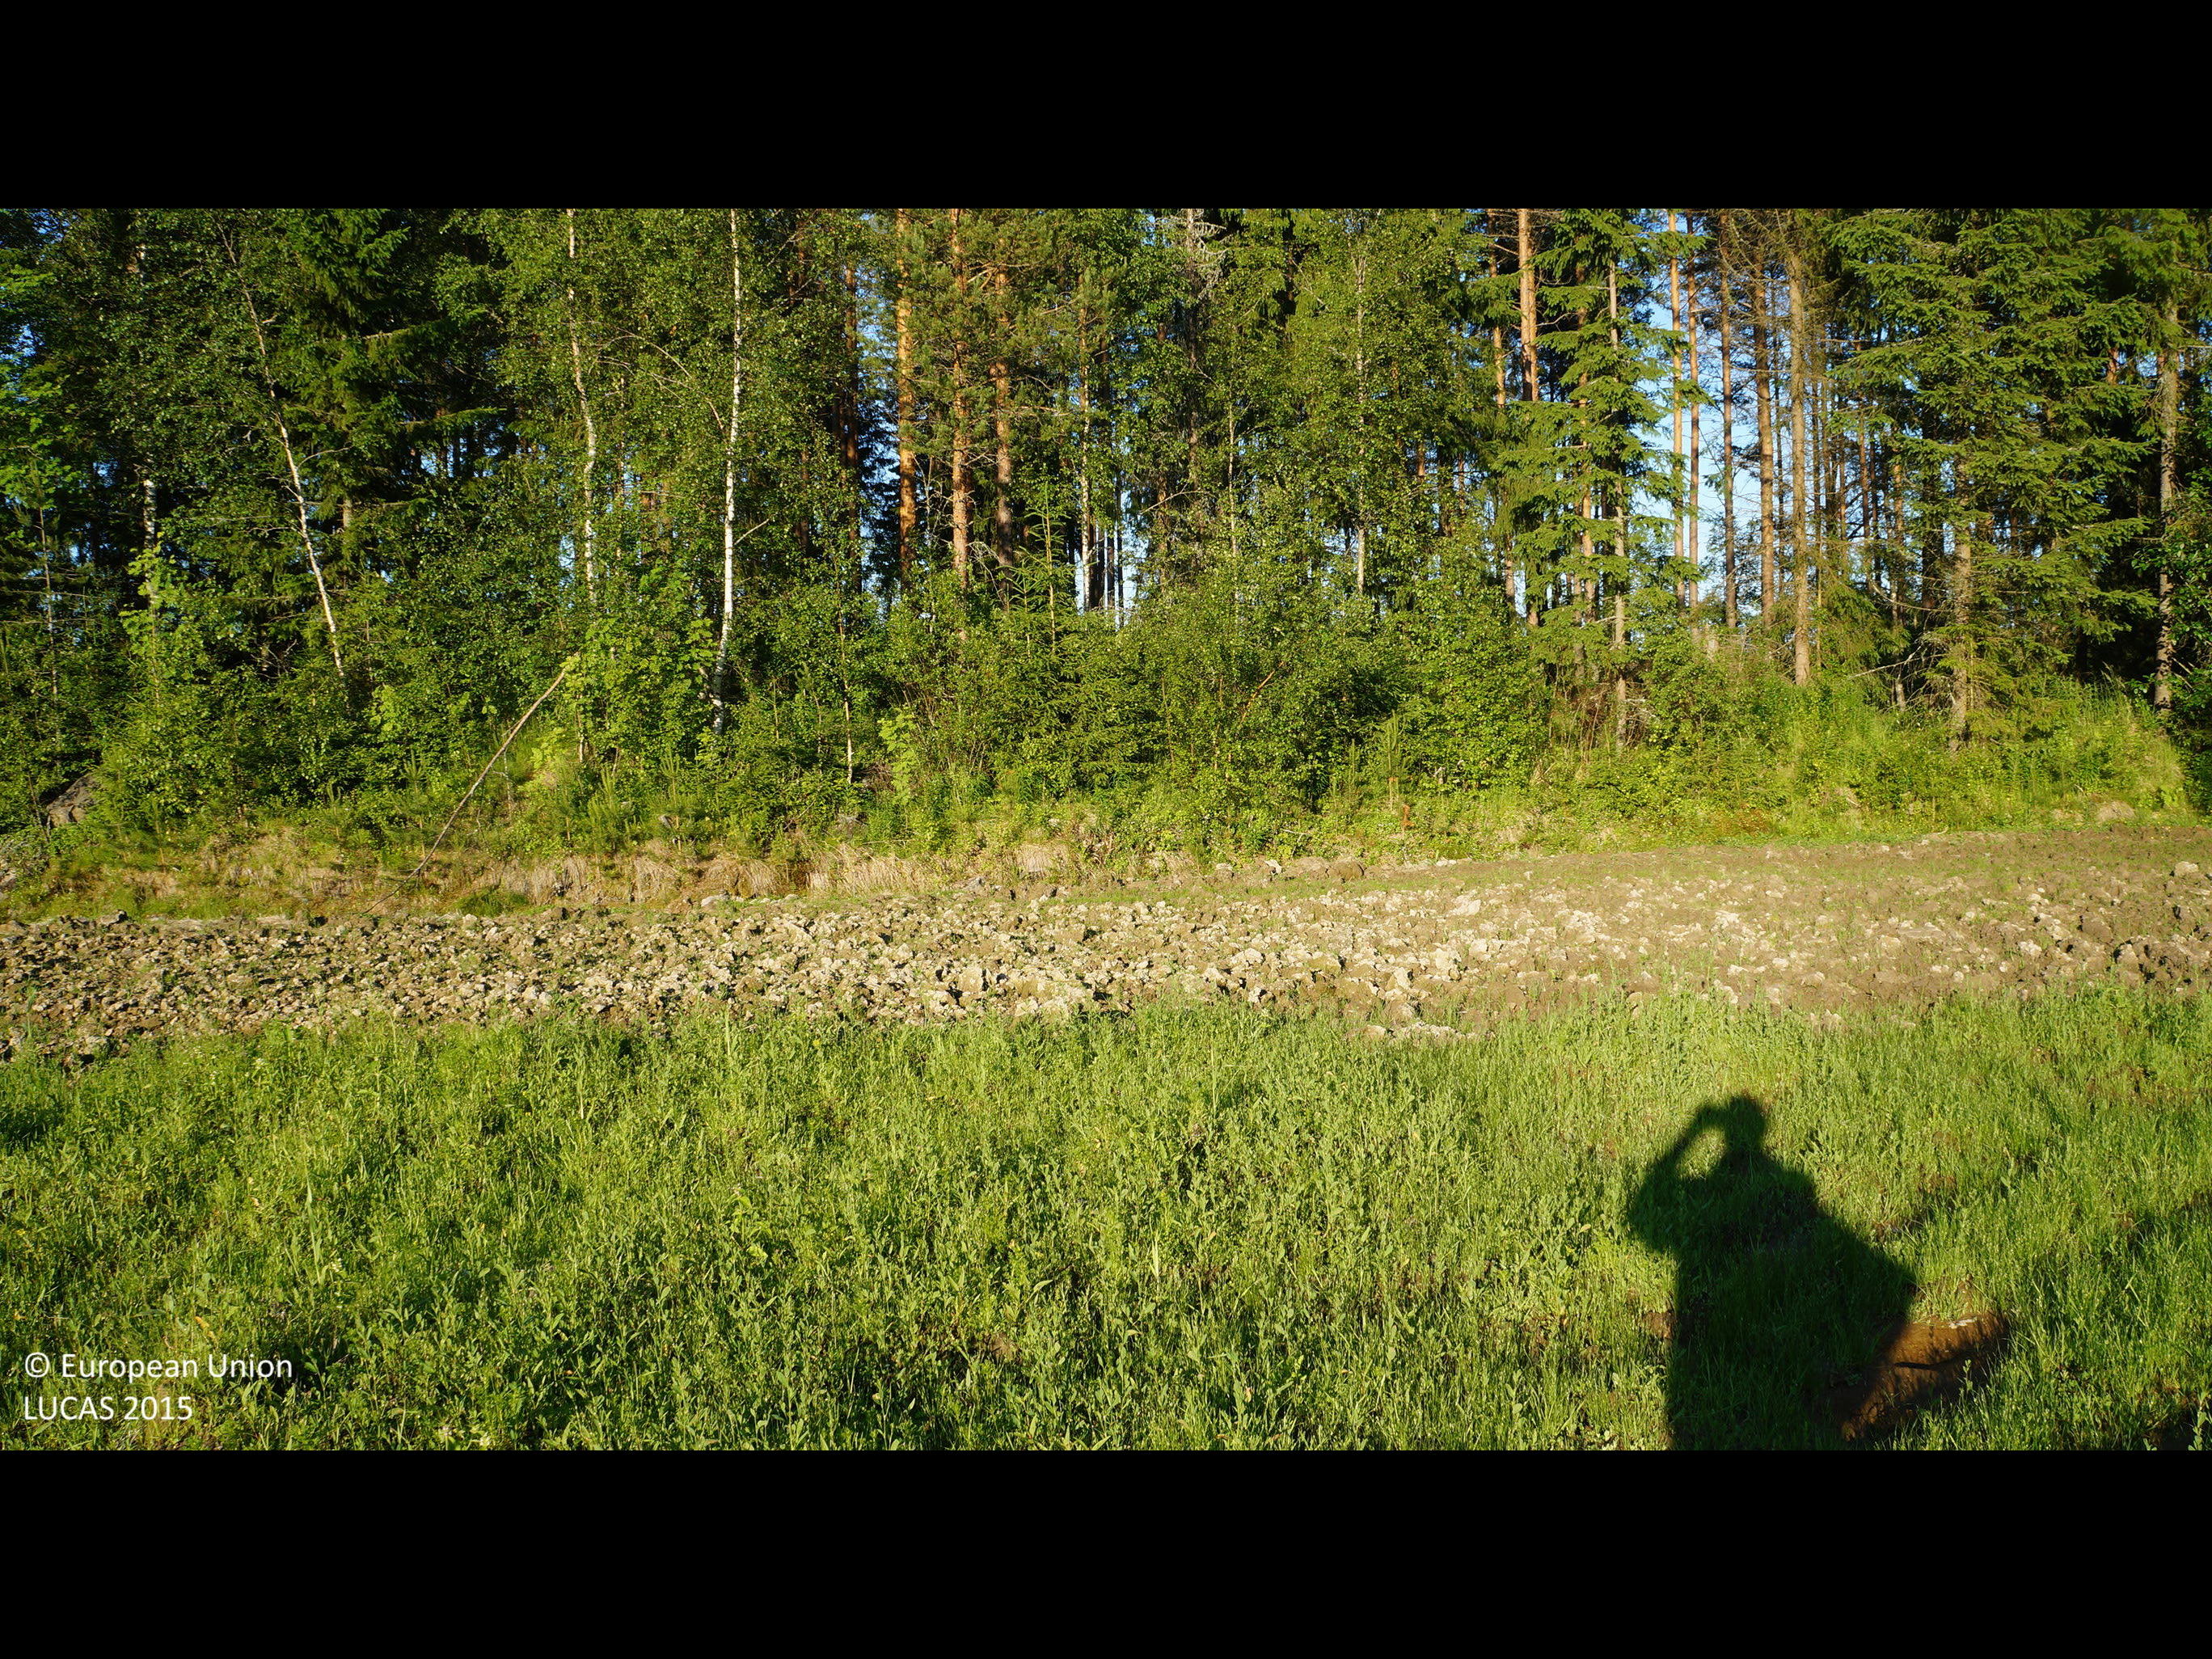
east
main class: Grassland
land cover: Grassland without tree/shrub cover
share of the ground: > 75 %
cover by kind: herbaceous plants 95 %, unconsolidated bare surface 5 %
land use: Agriculture (excluding fallow land and kitchen gardens)
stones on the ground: < 10 %
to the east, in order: Grassland without tree/shrub cover; Ditches and canals; Pine dominated mixed woodland; Tracks; Pine dominated mixed woodland; Tracks; Pine dominated coniferous woodland; Abandoned hedges; Ditches and canals; Electric lines; Spontaneously vegetated surfaces; Paved roads, cycling and walking lanes; Spontaneously vegetated surfaces; Ditches and canals; Tracks; Barley
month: July
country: FI
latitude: 63.6832
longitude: 22.9299
